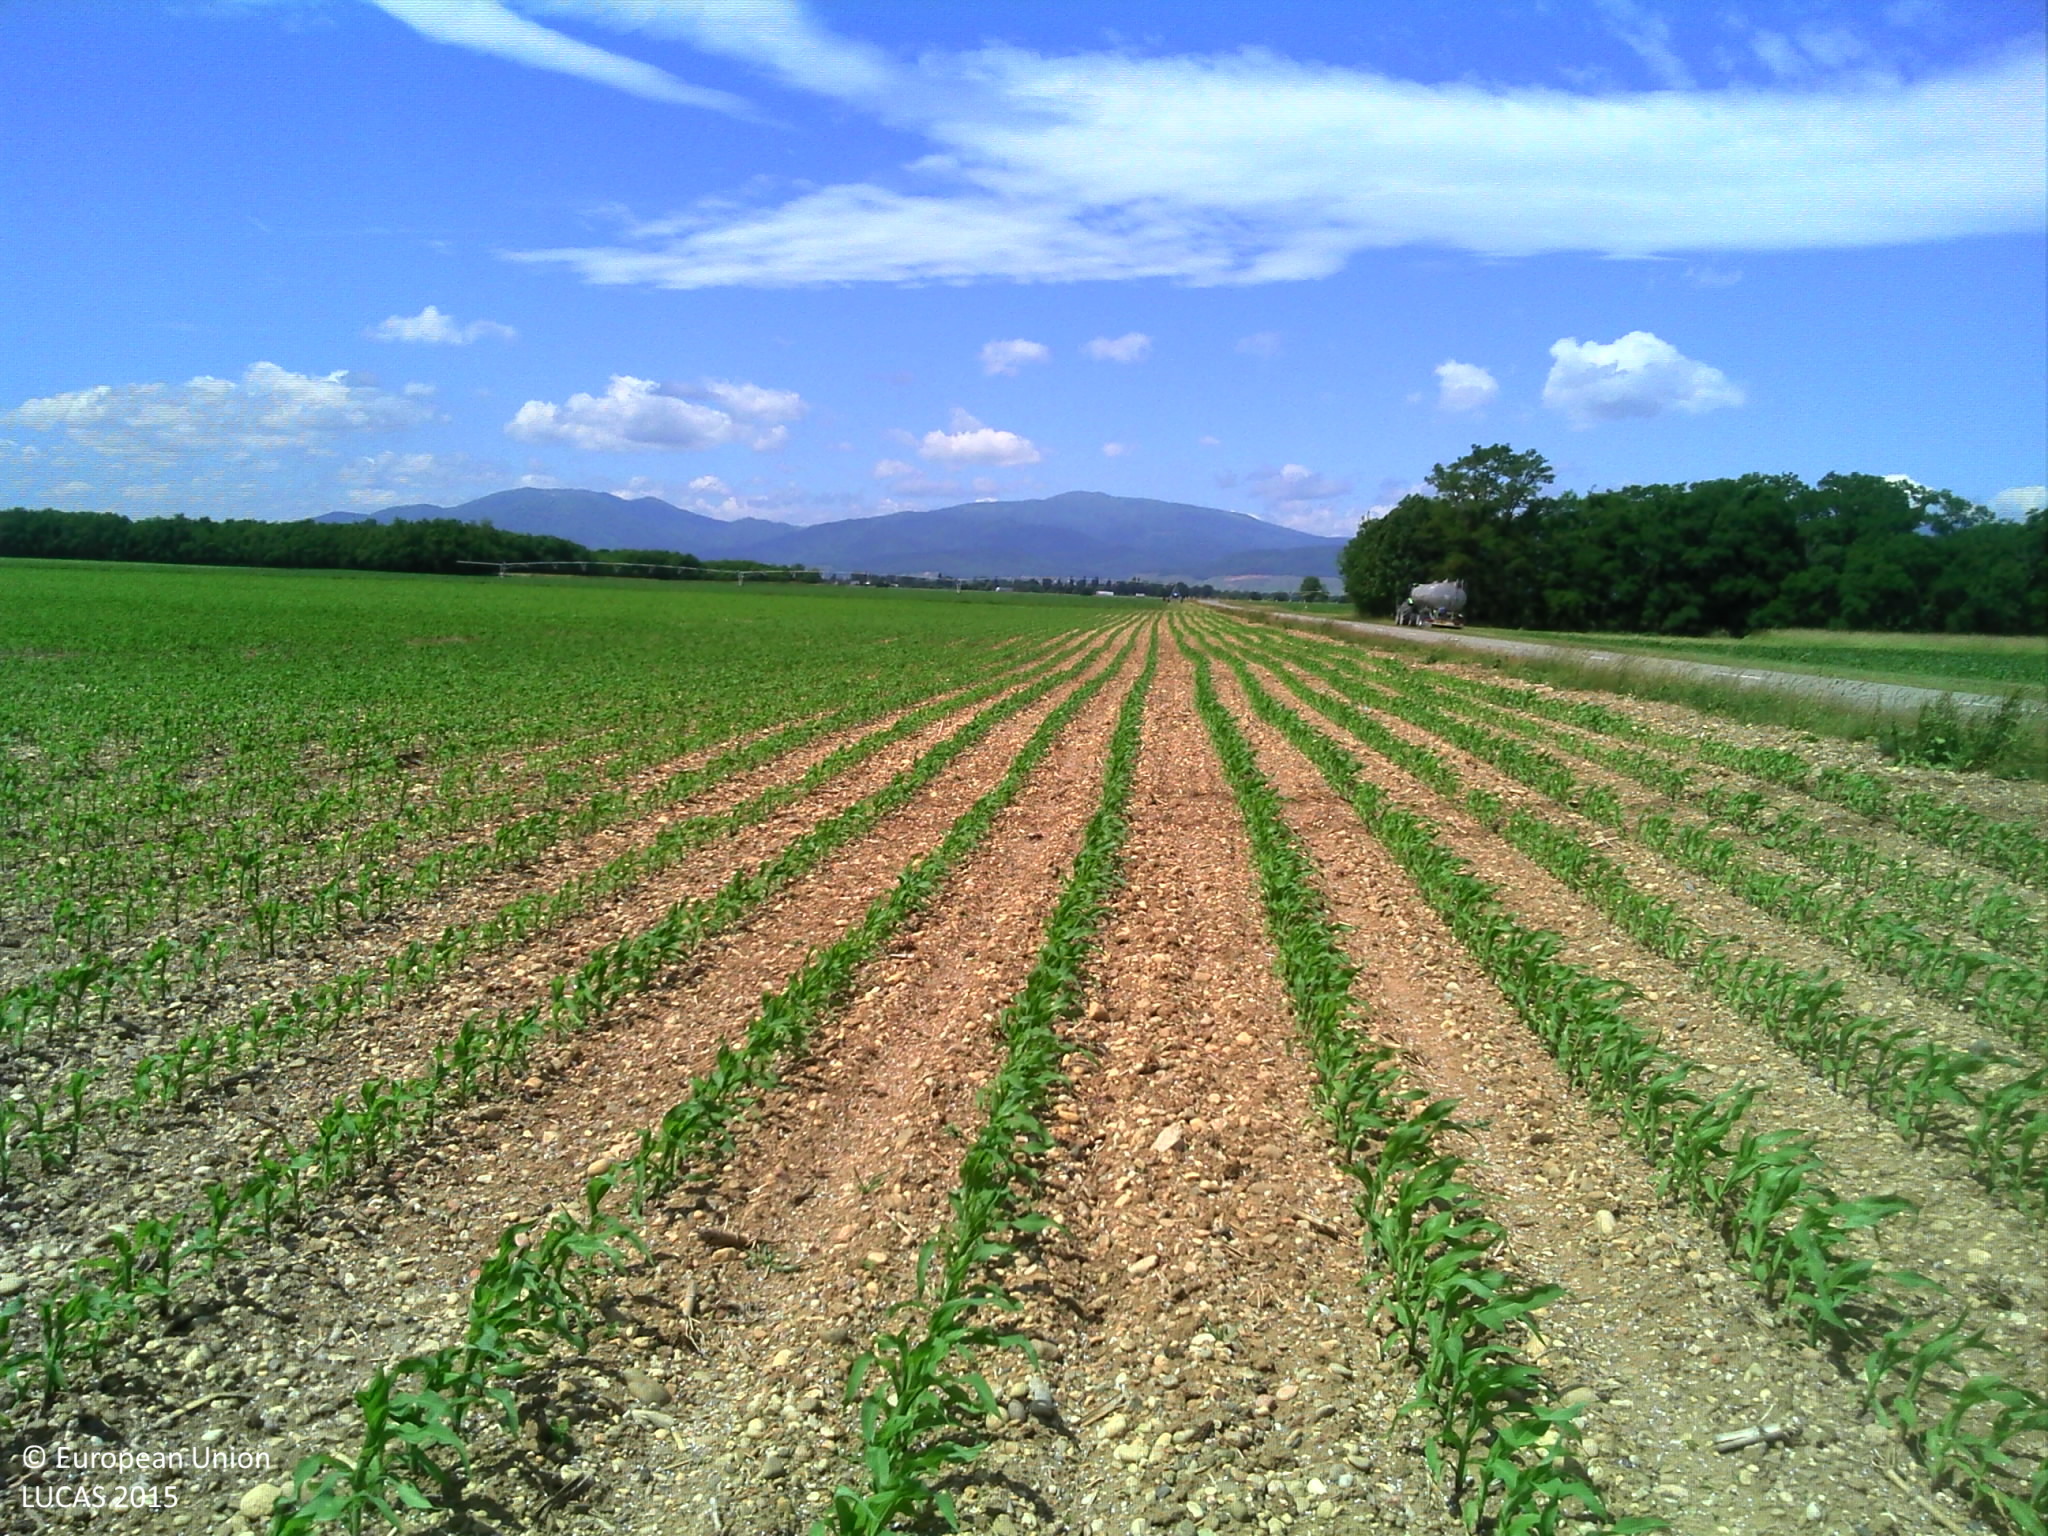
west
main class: Cropland
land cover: Maize
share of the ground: < 10 %
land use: Agriculture (excluding fallow land and kitchen gardens)
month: June
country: FR
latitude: 47.9046
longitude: 7.3926
